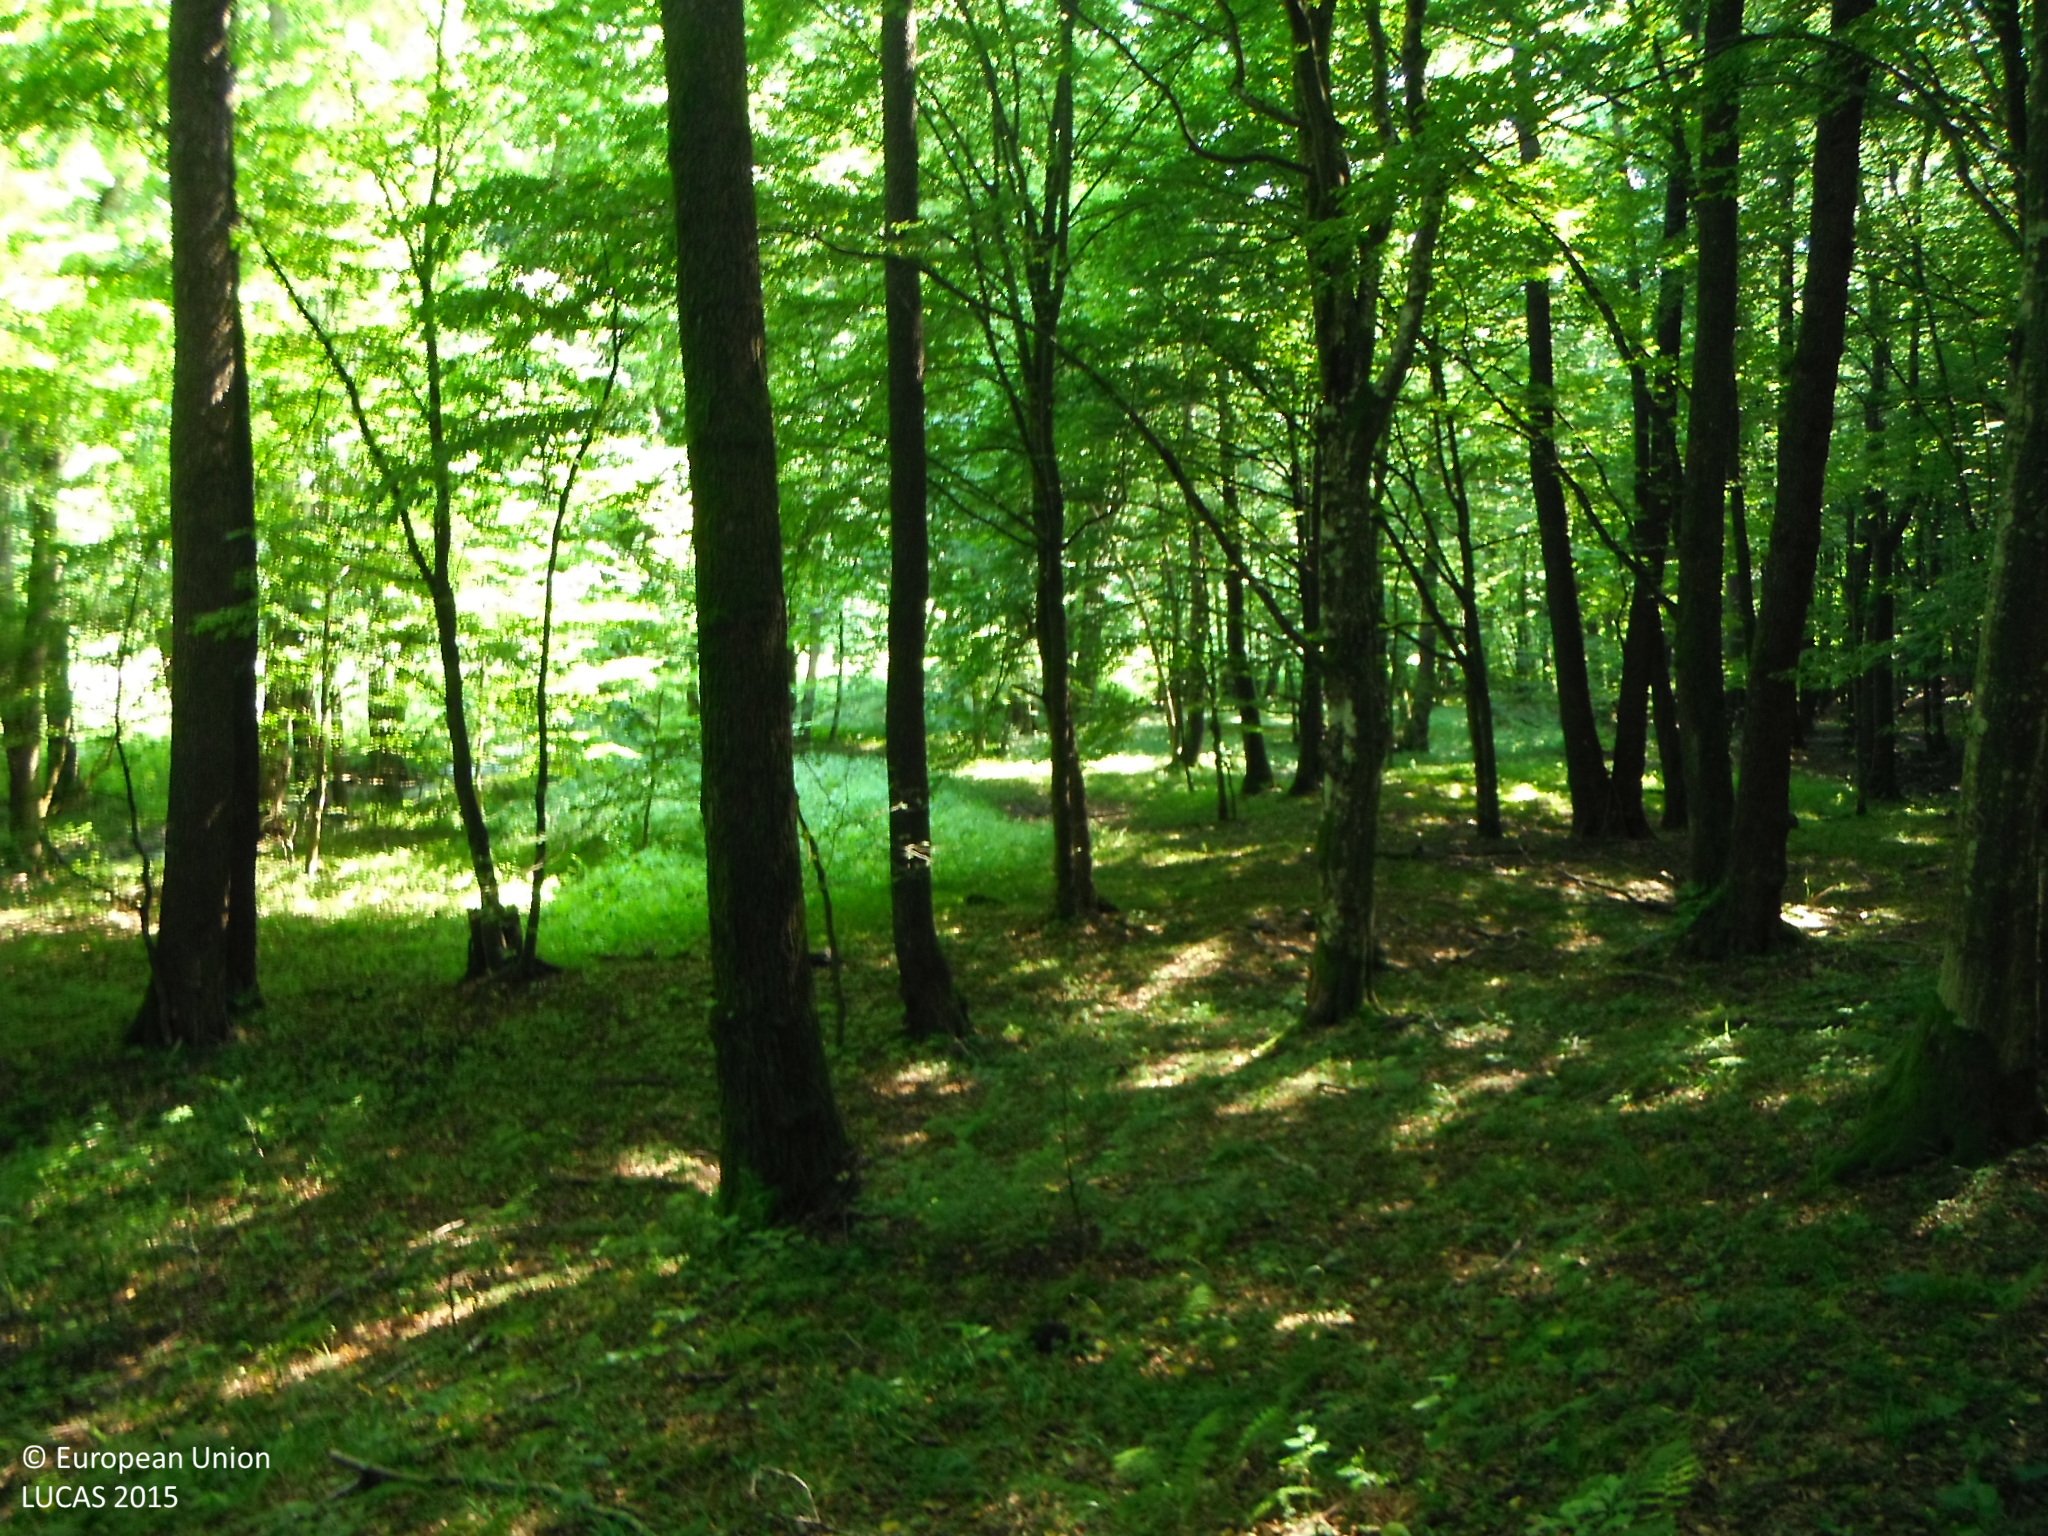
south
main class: Woodland
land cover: Broadleaved woodland
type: mesophytic deciduous forest
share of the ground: > 75 %
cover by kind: broadleaved forest trees 100 %
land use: Forestry
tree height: > 5 m
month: August
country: SK
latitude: 48.6942
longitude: 20.5650
